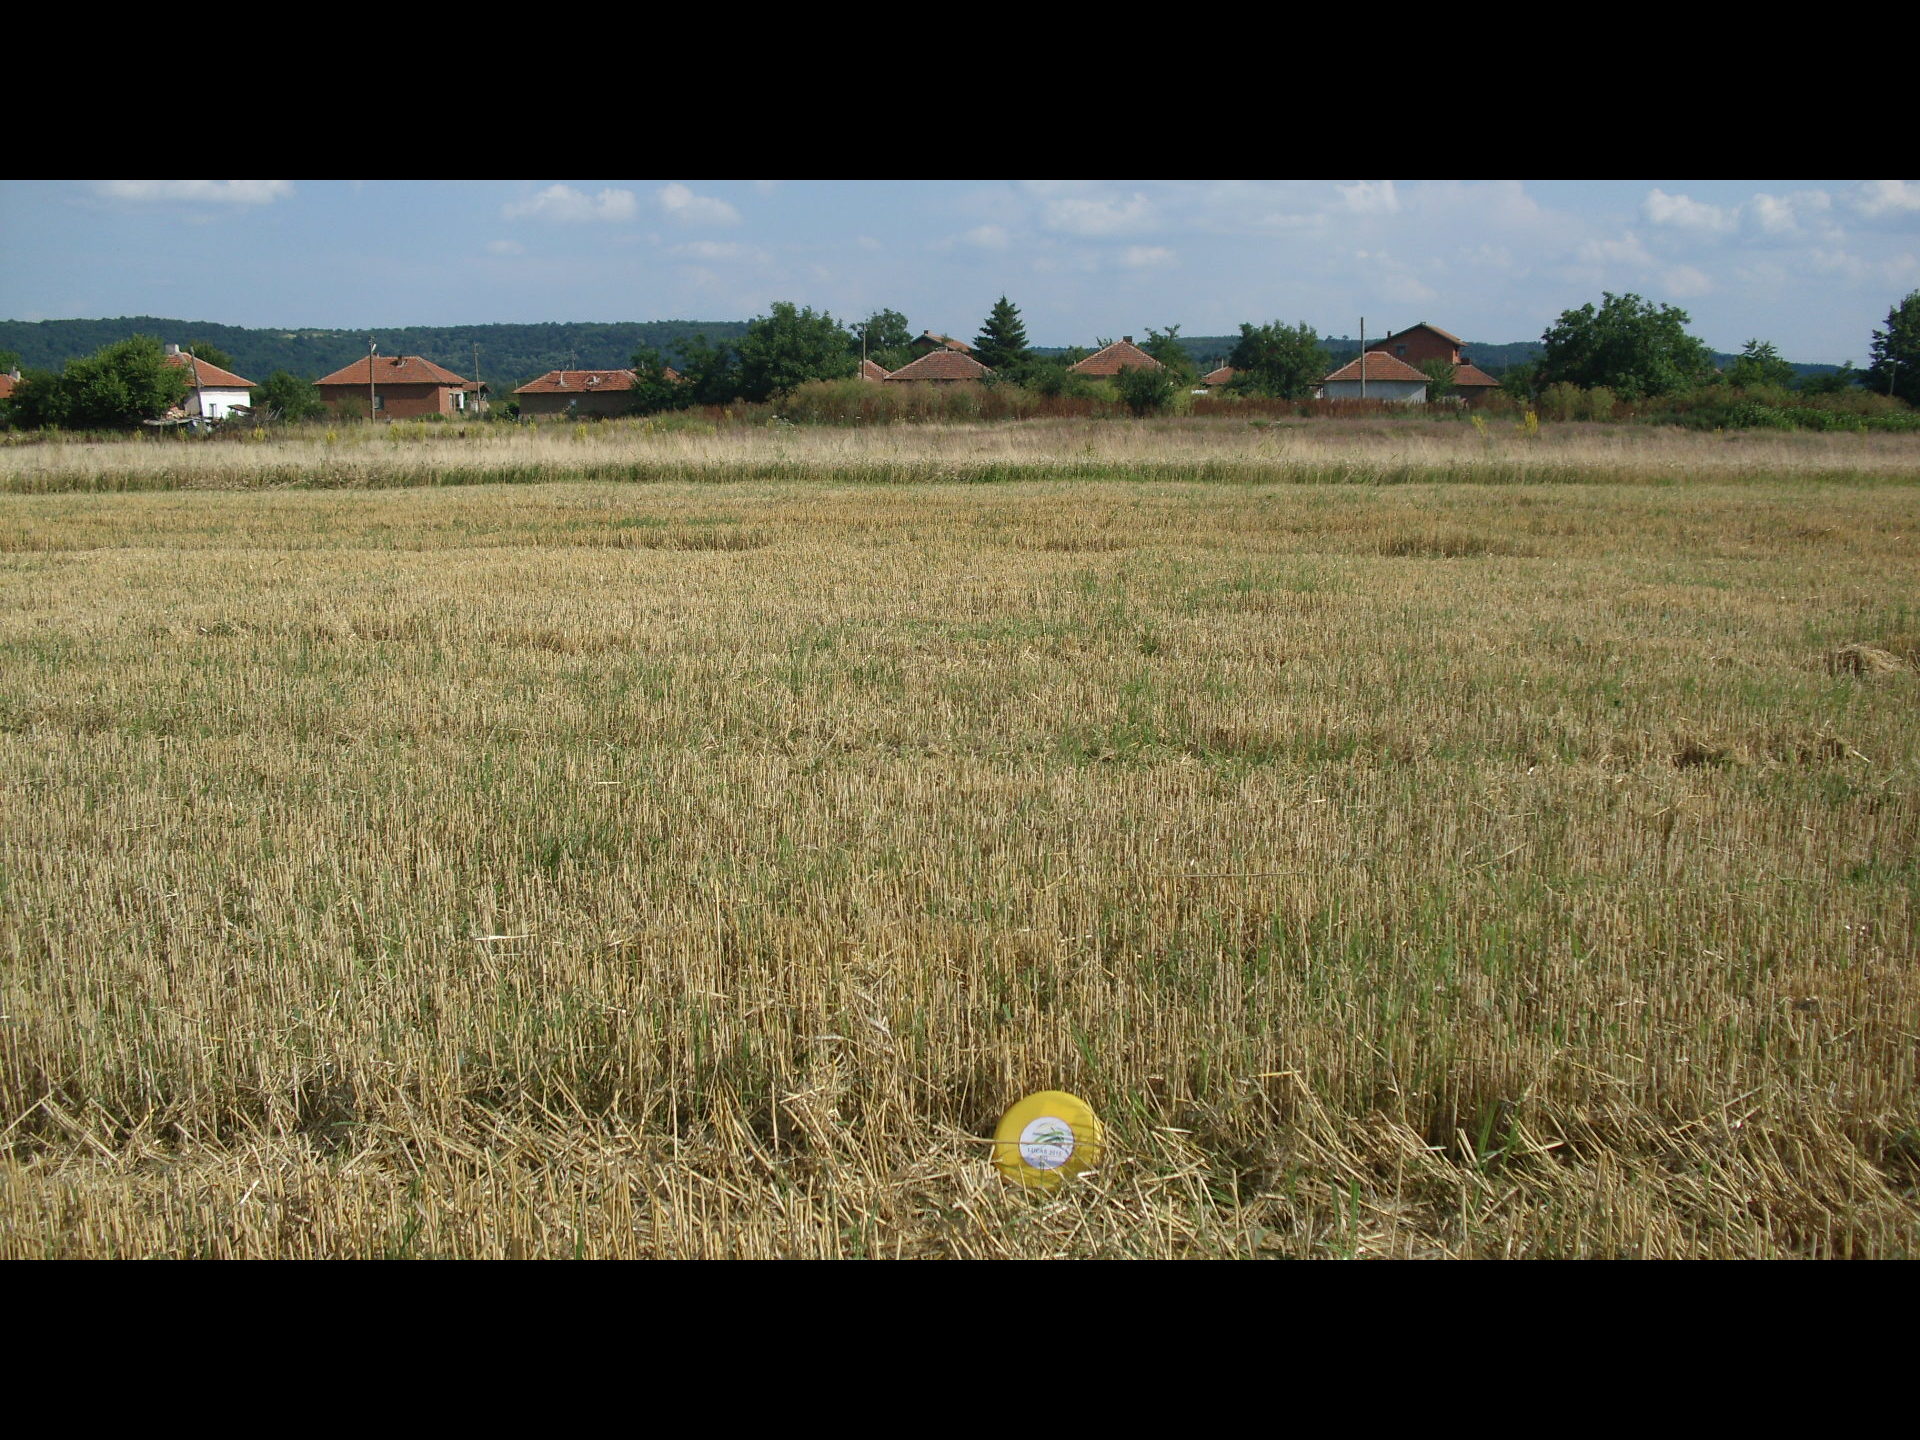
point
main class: Cropland
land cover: Common wheat
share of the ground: > 75 %
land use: Agriculture (excluding fallow land and kitchen gardens)
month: July
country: BG
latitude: 43.7155
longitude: 23.1102
